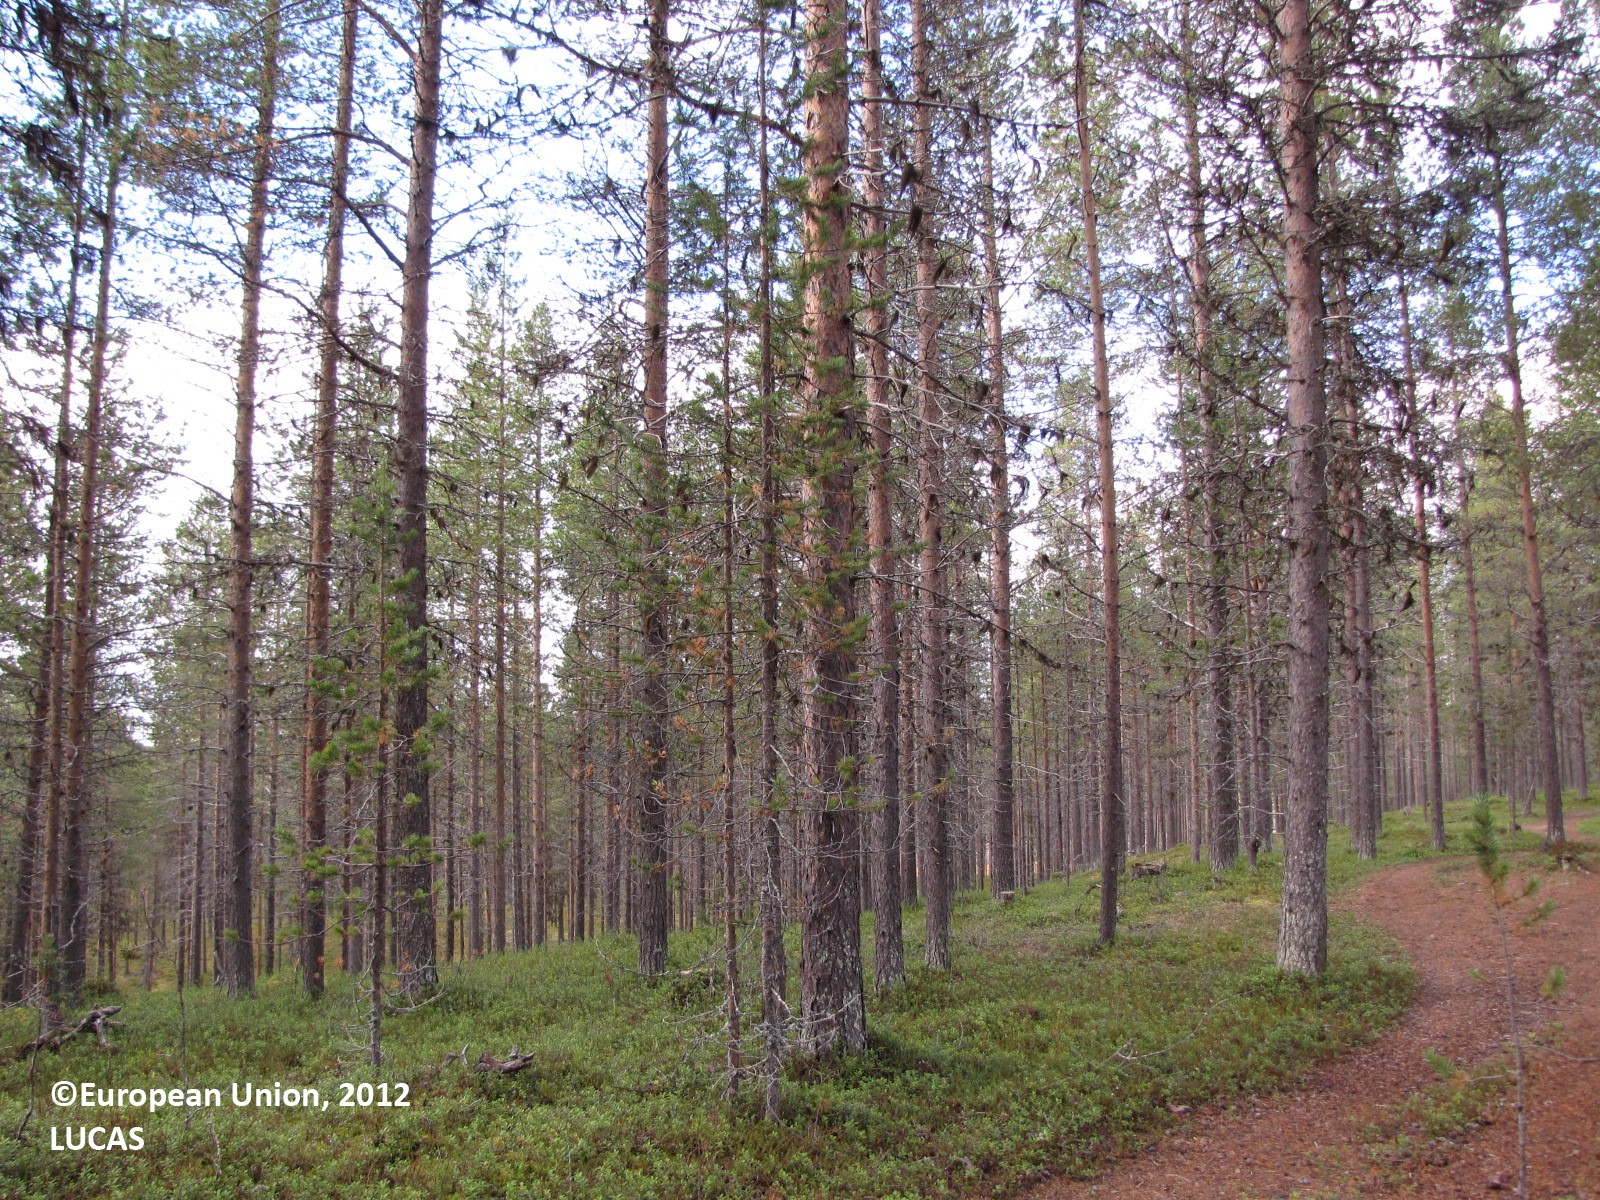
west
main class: Woodland
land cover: Pine dominated coniferous woodland
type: boreal forest
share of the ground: 25 - 50 %
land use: Forestry
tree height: > 5 m
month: September
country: FI
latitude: 67.8669
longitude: 23.5448
